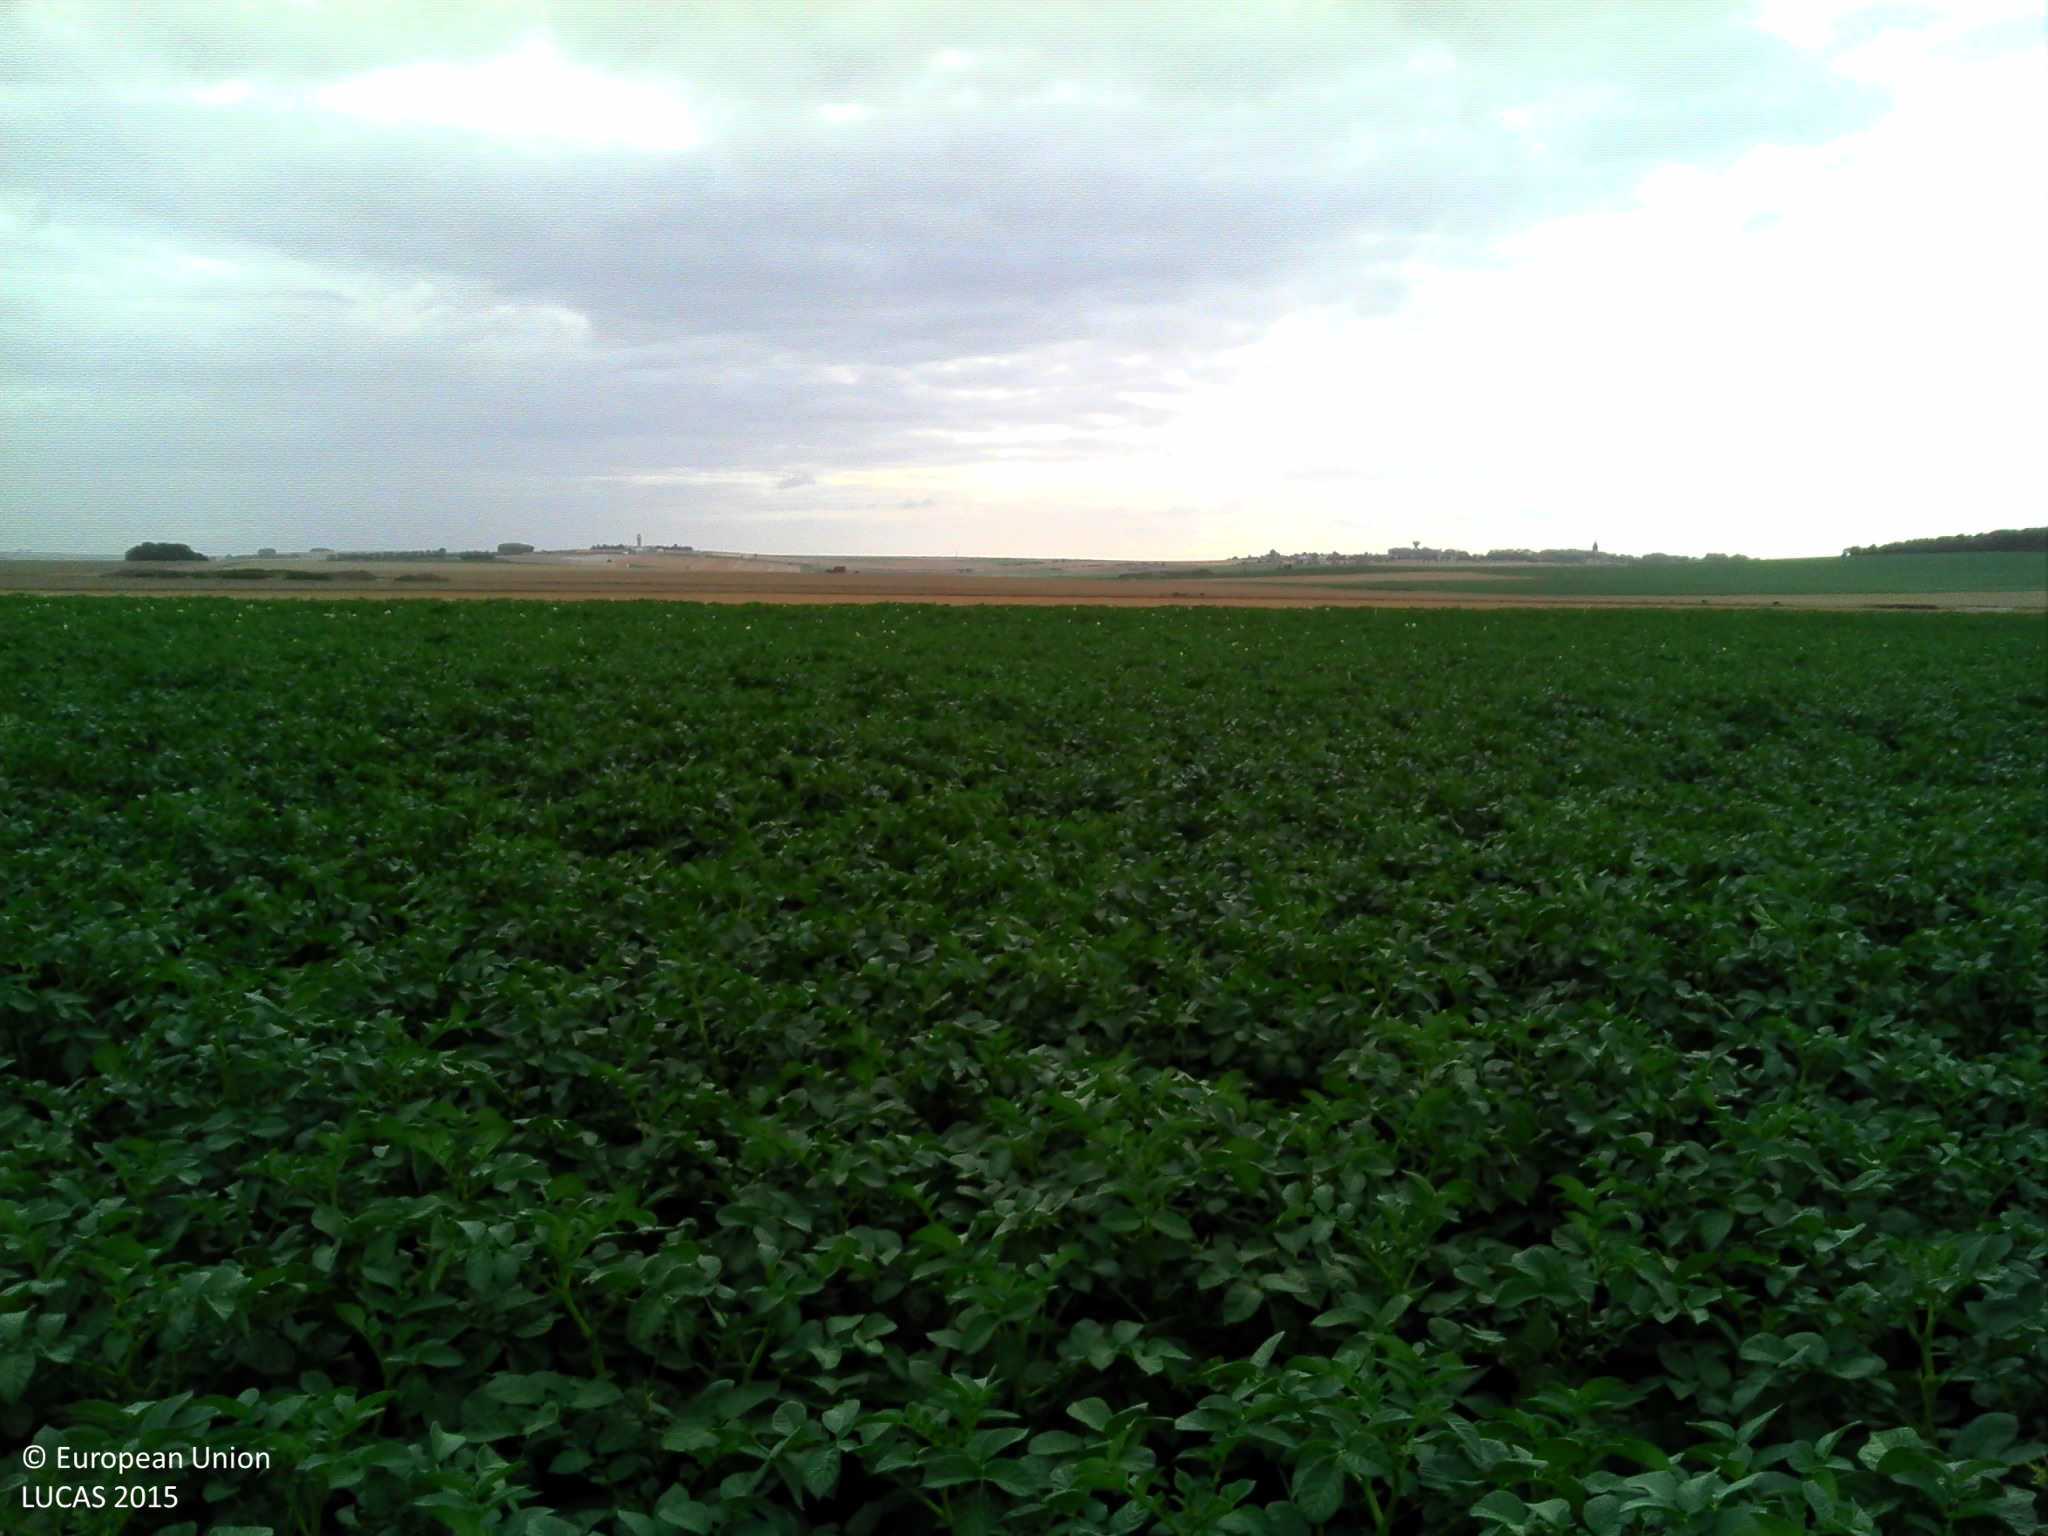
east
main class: Cropland
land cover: Potatoes
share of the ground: > 75 %
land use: Agriculture (excluding fallow land and kitchen gardens)
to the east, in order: Potatoes; Common wheat
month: July
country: FR
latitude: 49.8801
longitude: 2.4587
